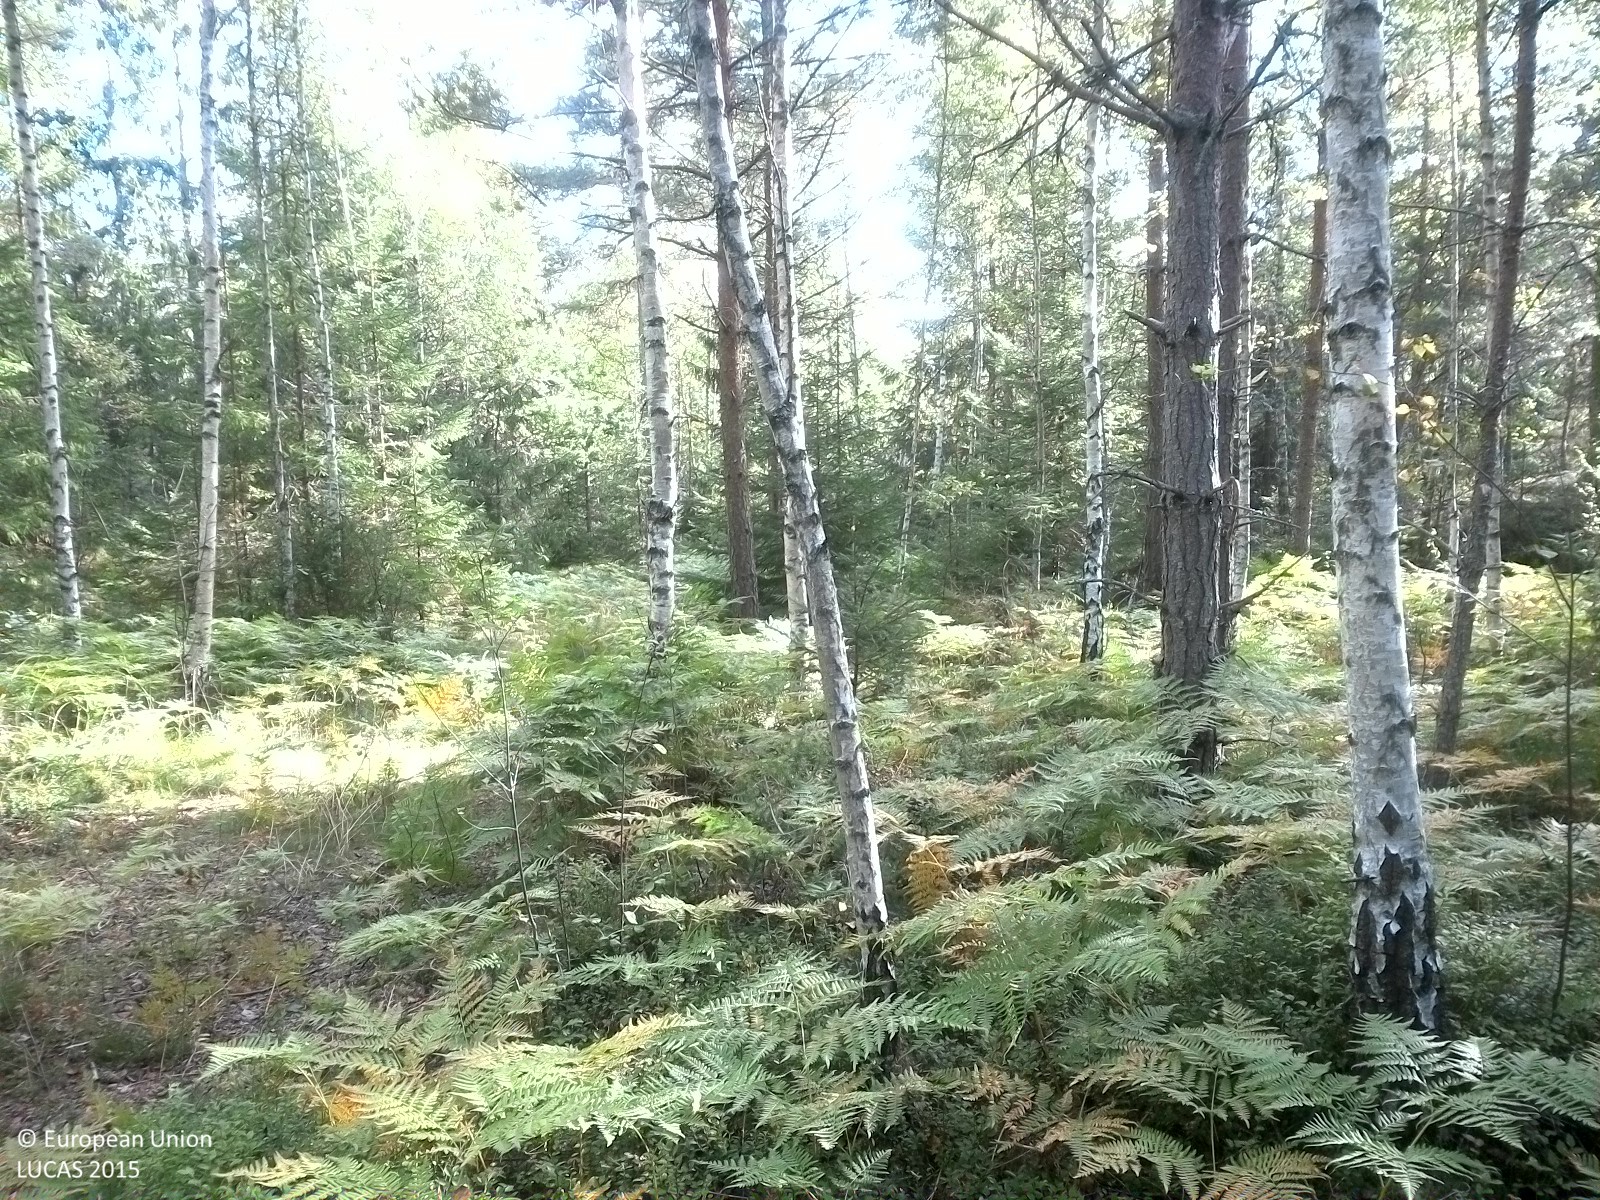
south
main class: Woodland
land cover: Pine dominated mixed woodland
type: boreal forest
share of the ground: 25 - 50 %
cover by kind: herbaceous plants 45 %, coniferous forest trees 25 %, broadleaved forest trees 20 %, lichens and mosses 10 %
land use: Forestry
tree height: > 5 m
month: September
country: SE
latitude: 58.9940
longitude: 15.8584
